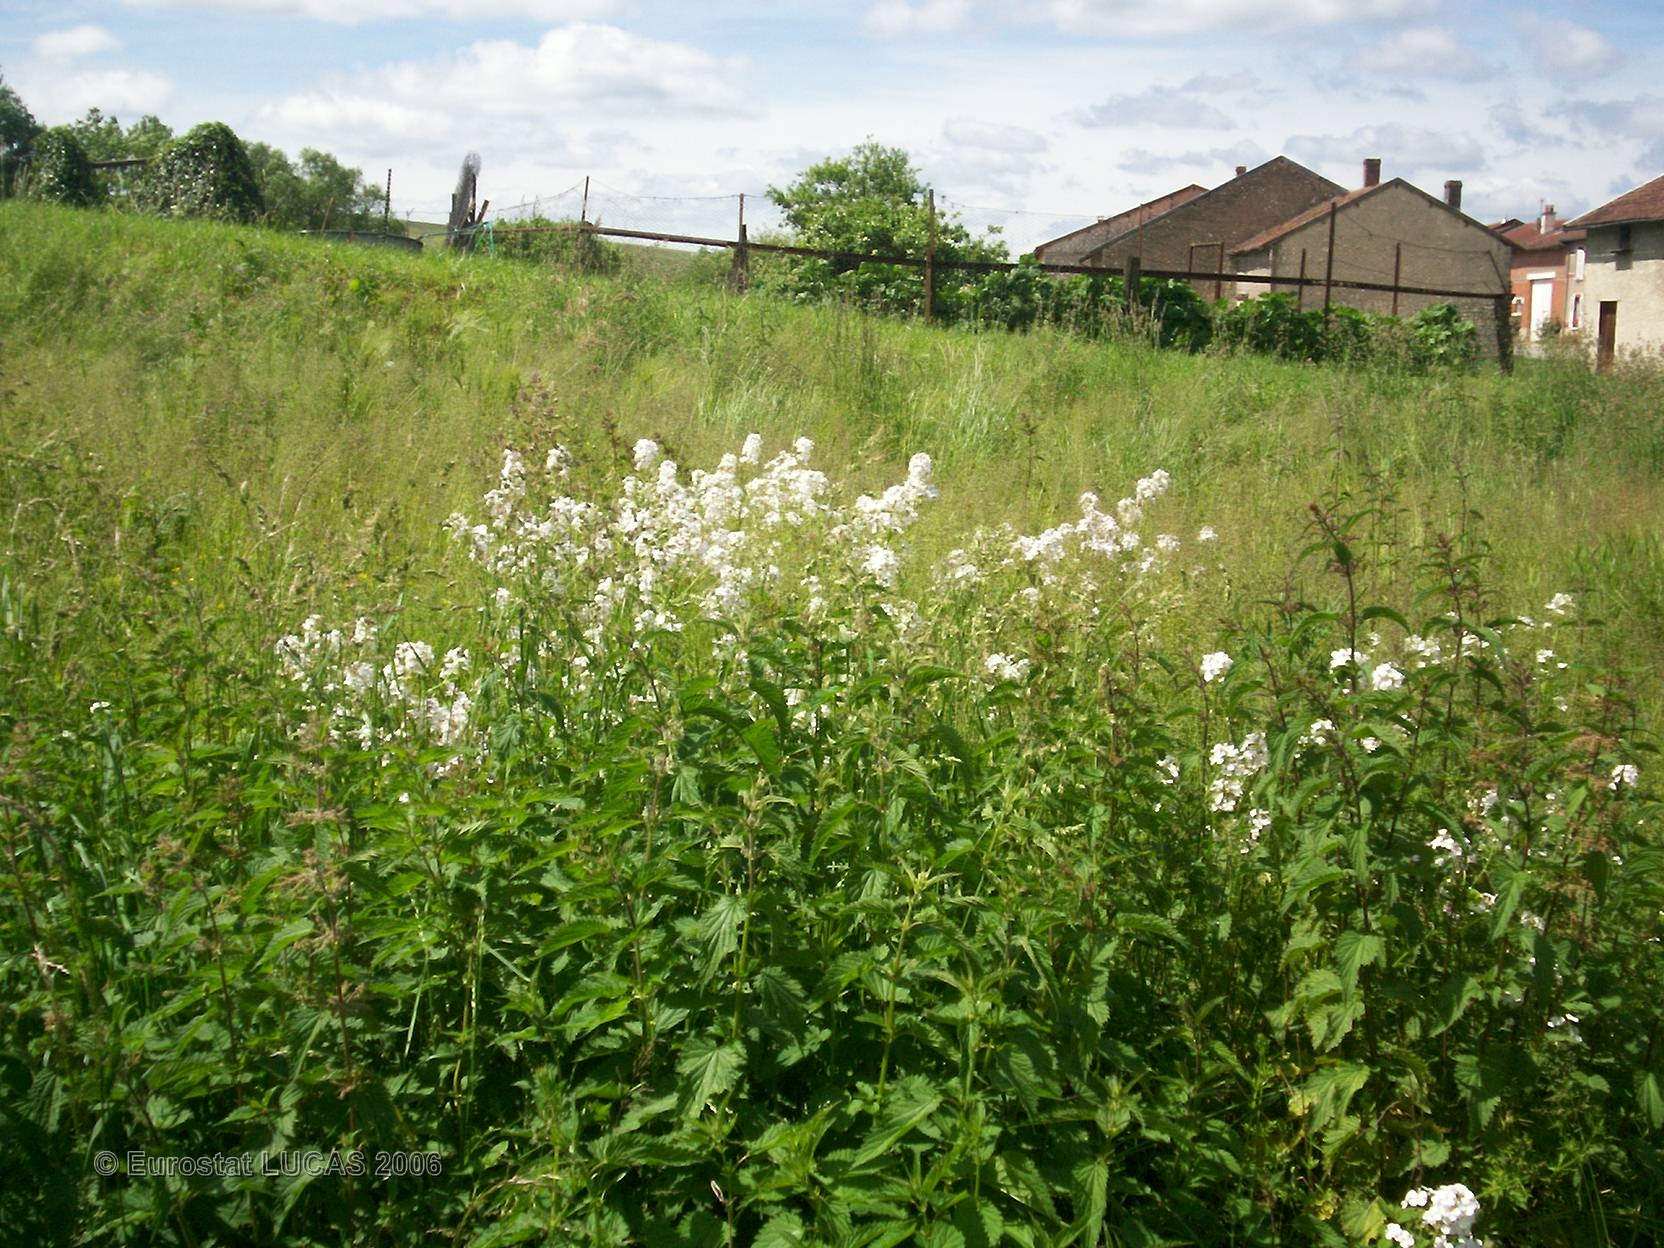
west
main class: Cropland
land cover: Other fresh vegetables
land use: Kitchen garden
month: June
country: FR
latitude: 49.2486
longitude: 5.0661
